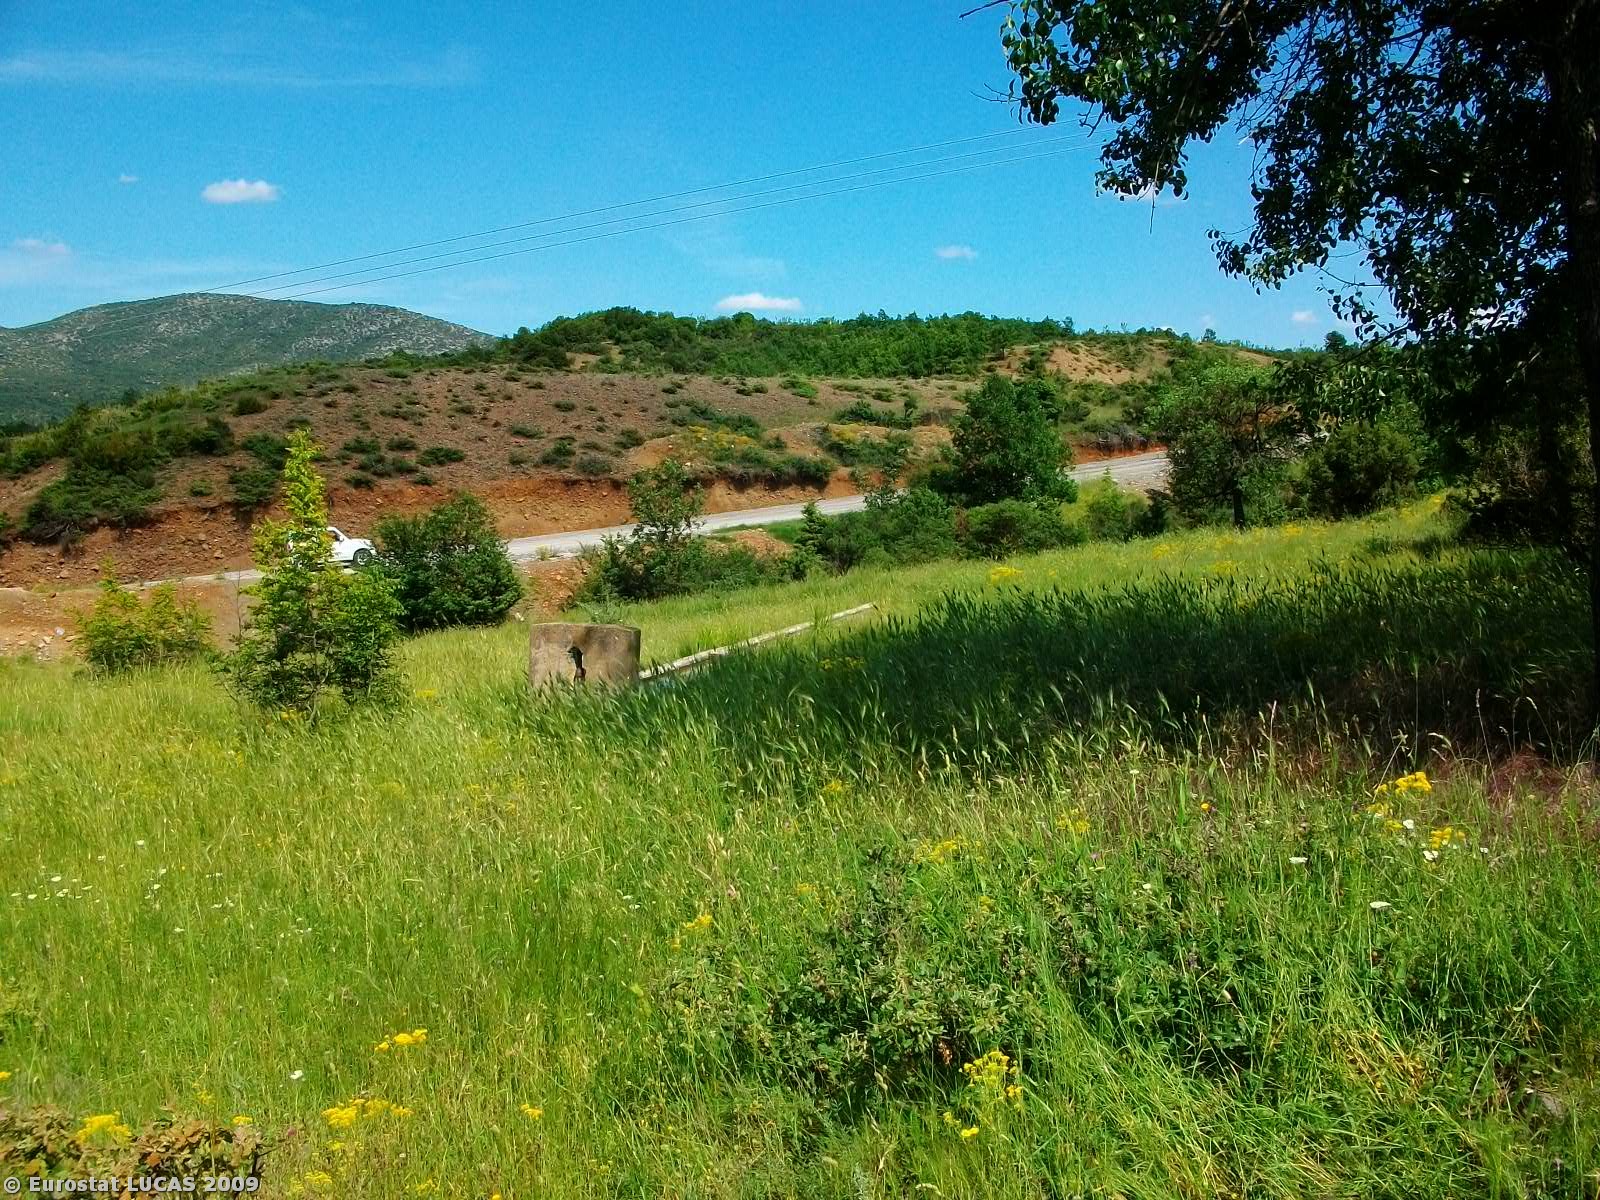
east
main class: Woodland
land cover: Broadleaved woodland
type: thermophilous deciduous forest
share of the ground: > 75 %
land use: Forestry
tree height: > 5 m
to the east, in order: Broadleaved woodland
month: June
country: GR
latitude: 40.0109
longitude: 21.7858
